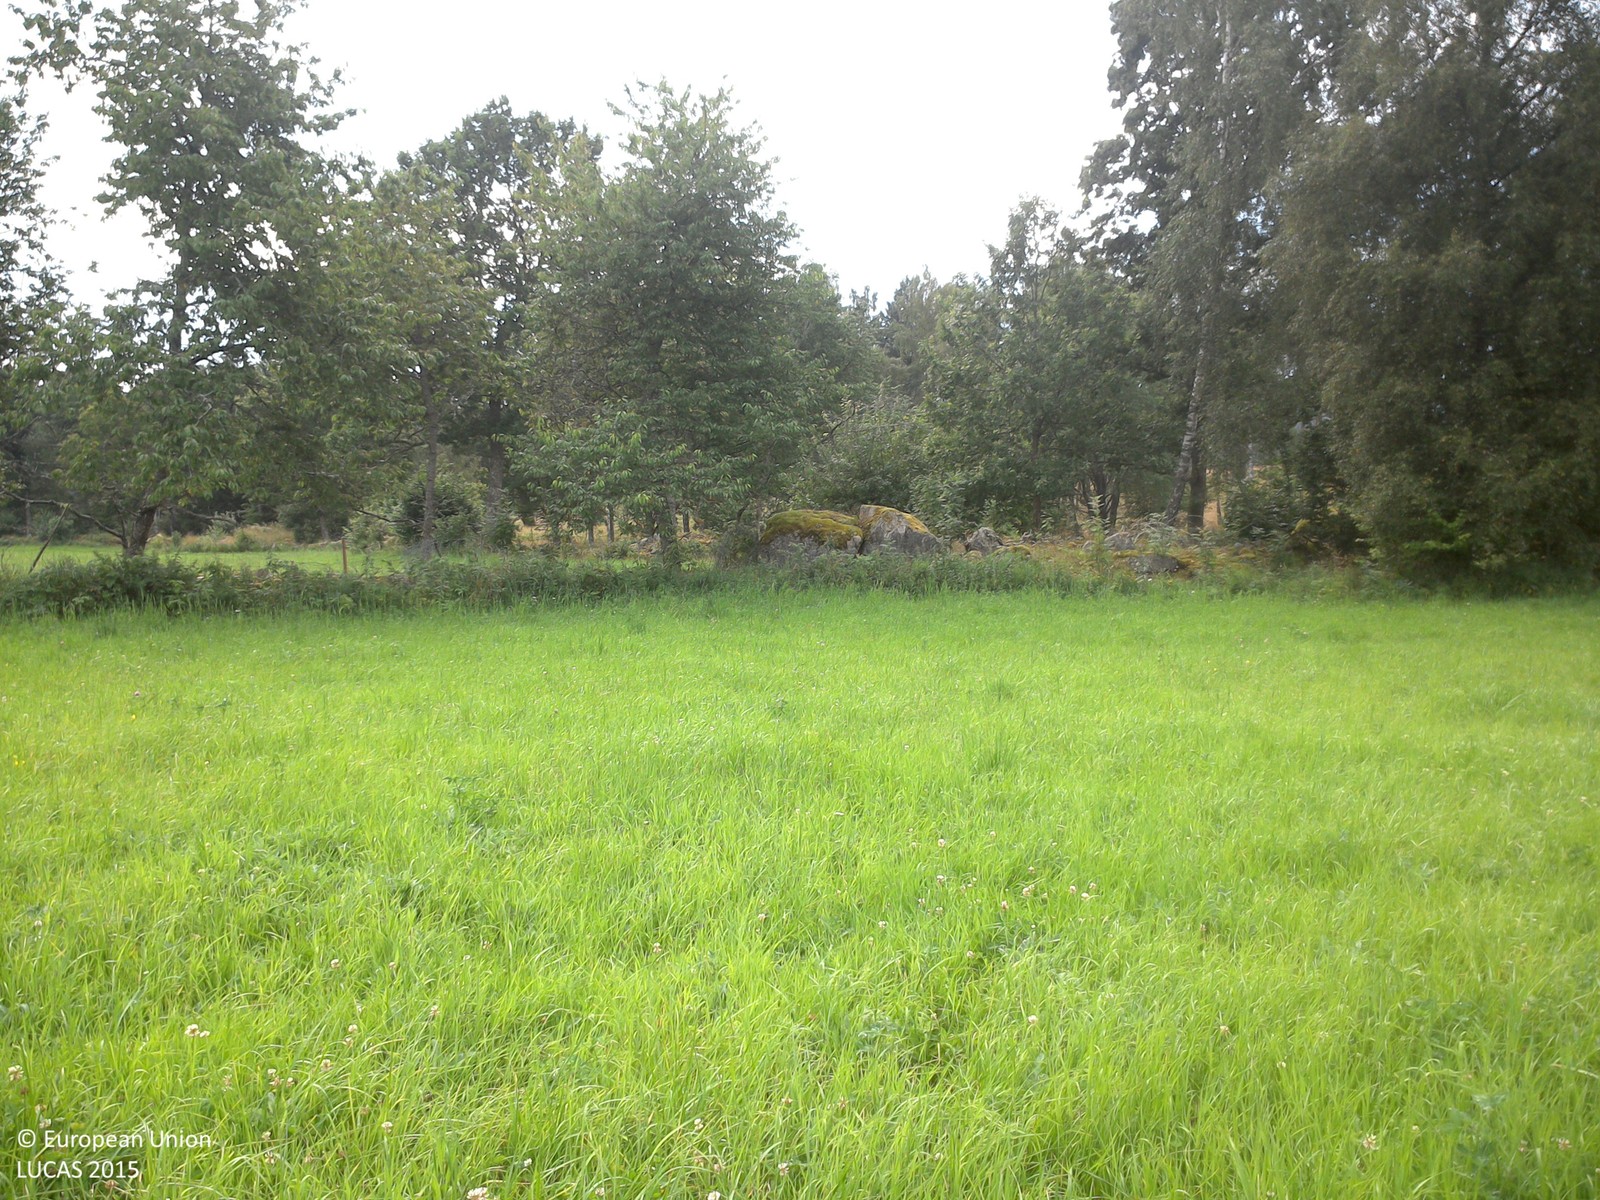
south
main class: Cropland
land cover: Other leguminous and mixtures for fodder
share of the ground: > 75 %
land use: Agriculture (excluding fallow land and kitchen gardens)
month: August
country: SE
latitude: 57.7330
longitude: 15.3870
